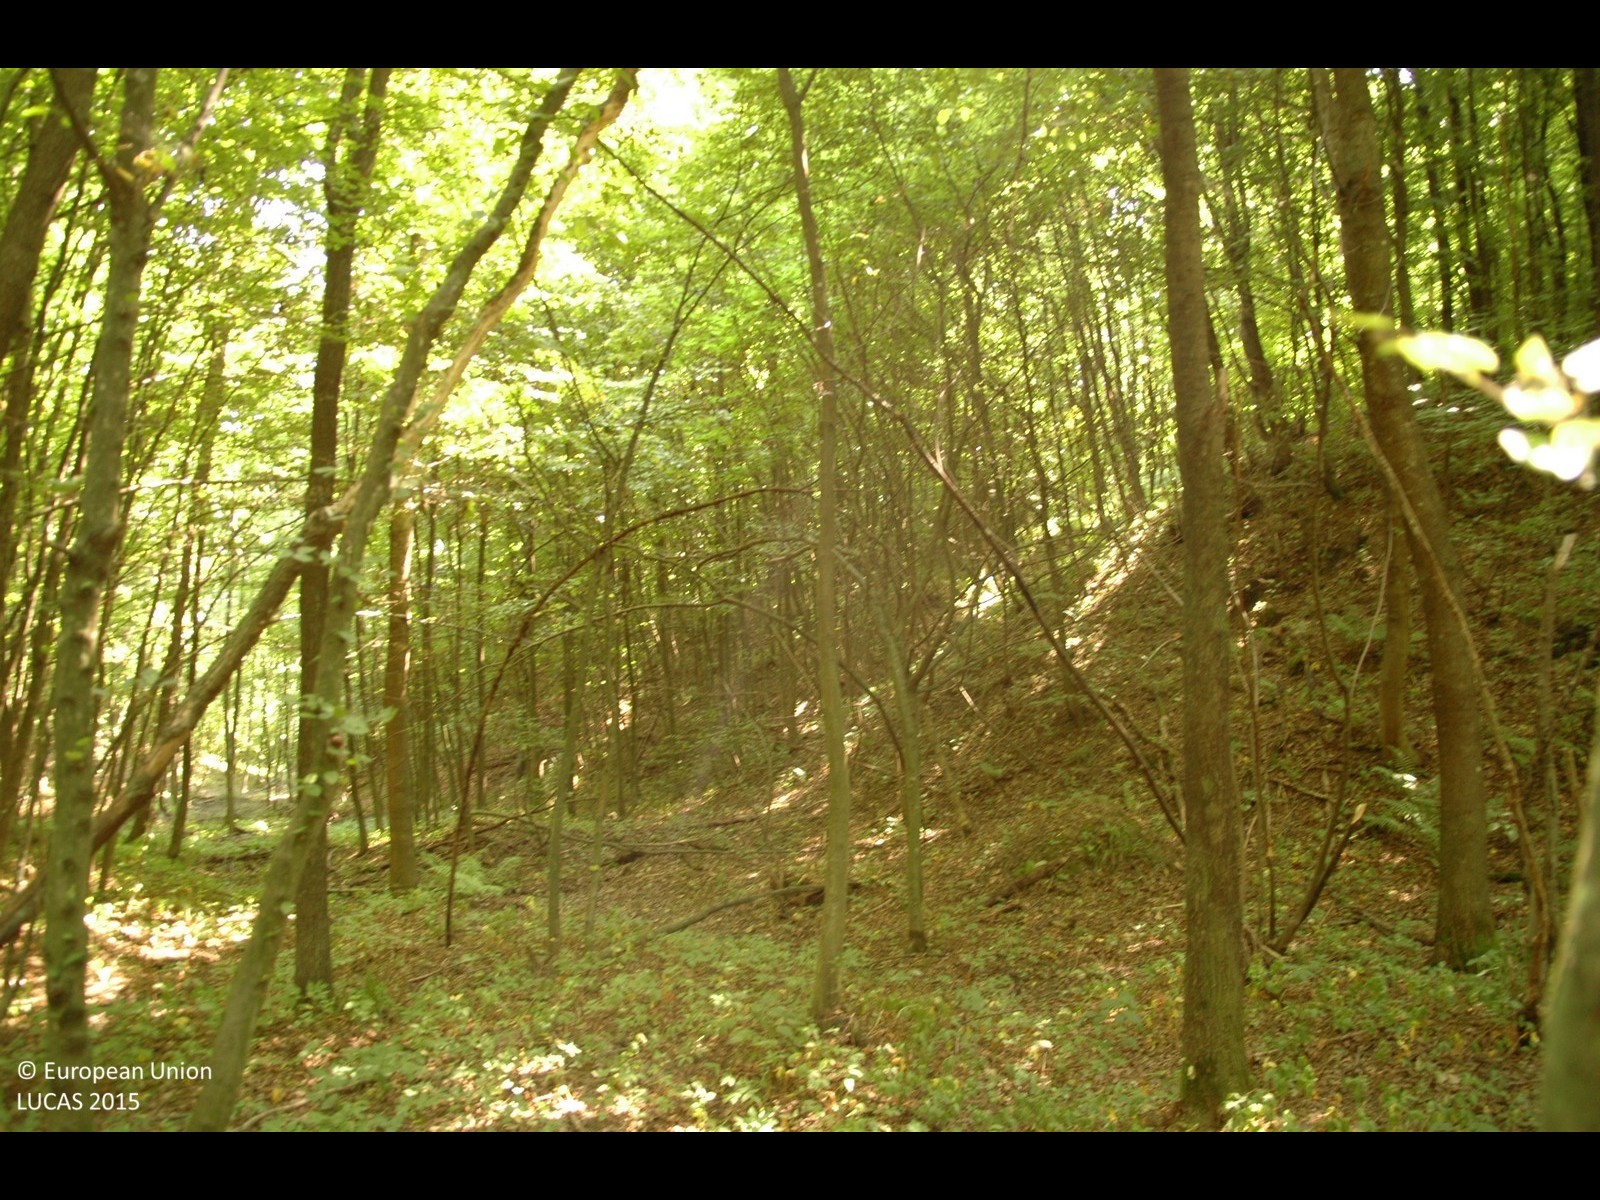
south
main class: Woodland
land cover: Broadleaved woodland
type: mesophytic deciduous forest
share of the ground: > 75 %
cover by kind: broadleaved forest trees 100 %
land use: Forestry
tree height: > 5 m
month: July
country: HR
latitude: 46.1594
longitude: 16.6958
